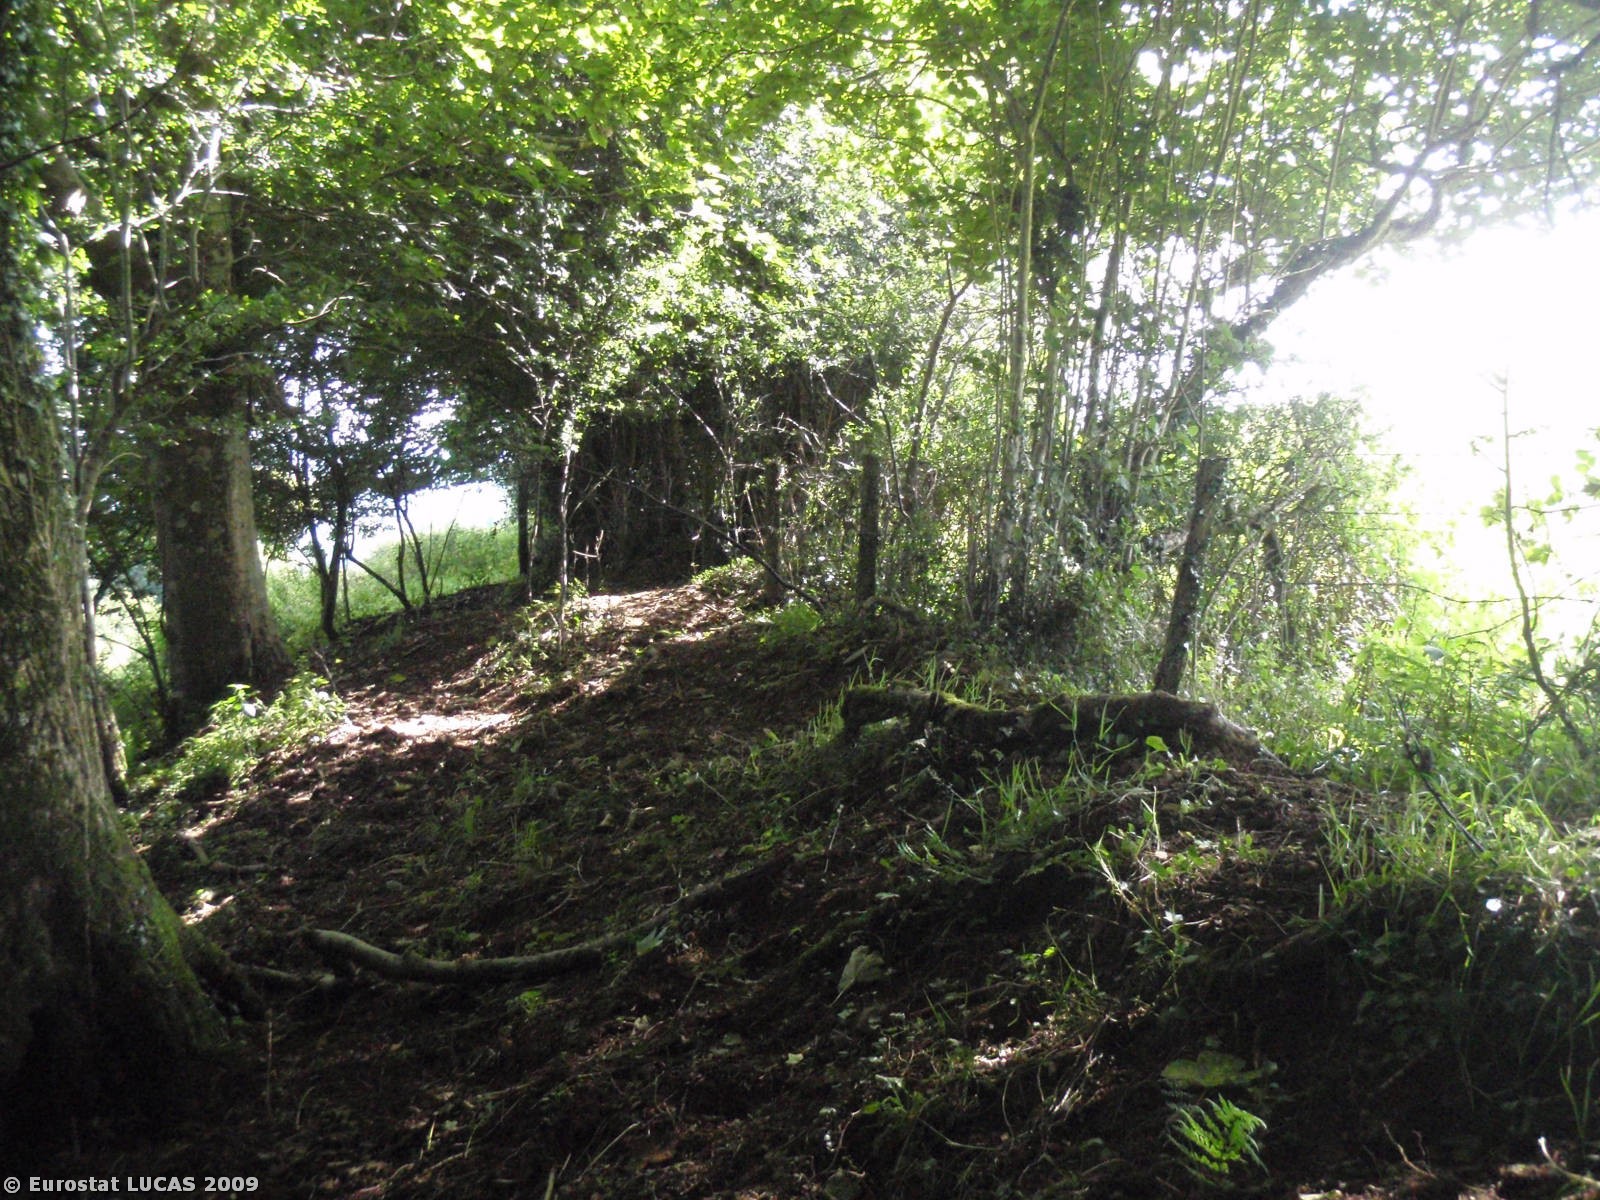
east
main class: Woodland
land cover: Broadleaved woodland
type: mesophytic deciduous forest
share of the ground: > 75 %
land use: Unused
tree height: > 5 m
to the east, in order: Broadleaved woodland; Fences; Grassland without tree/shrub cover; Managed hedges; Grassland without tree/shrub cover
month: August
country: GB
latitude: 50.6347
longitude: -4.3965
